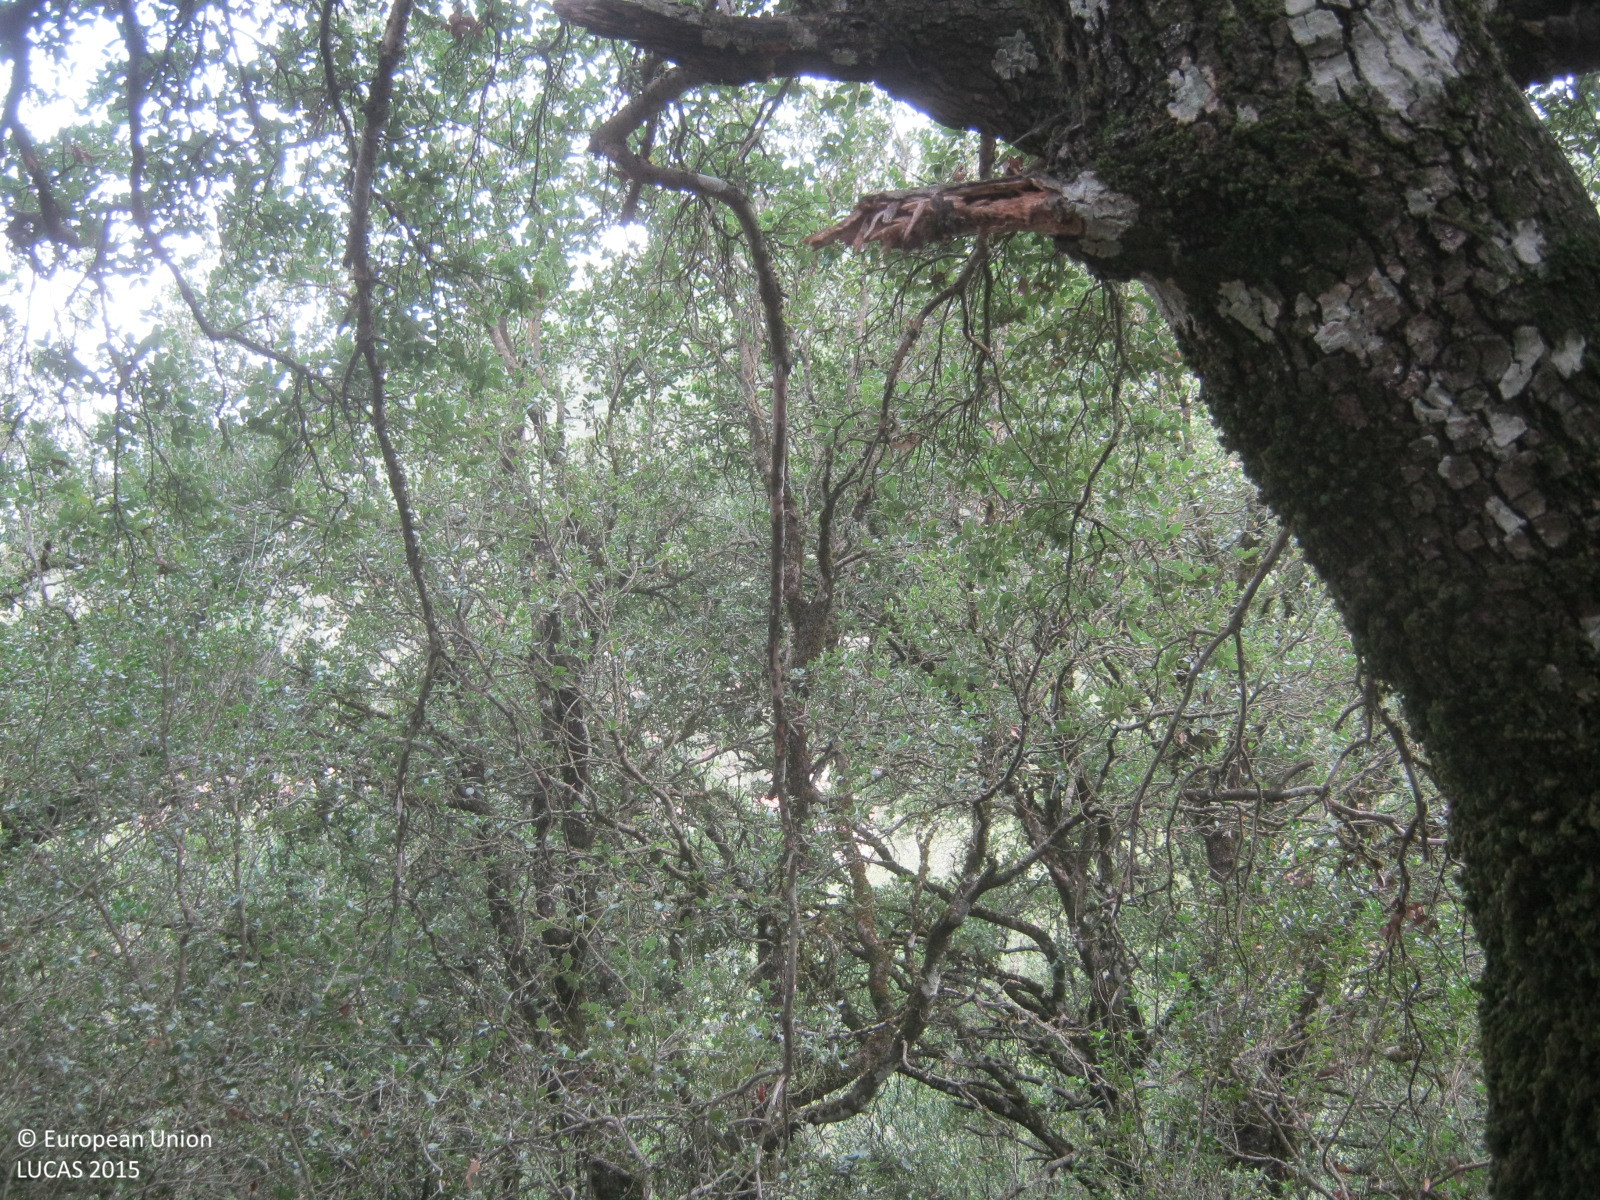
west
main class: Woodland
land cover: Broadleaved woodland
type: broadleaved evergreen forest
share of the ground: 50 - 75 %
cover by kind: broadleaved forest trees 65 %, shrubs 20 %, herbaceous plants 10 %, unconsolidated bare surface 5 %
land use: Semi-natural and natural areas not in use
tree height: > 5 m
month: September
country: GR
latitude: 37.8012
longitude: 22.0593
